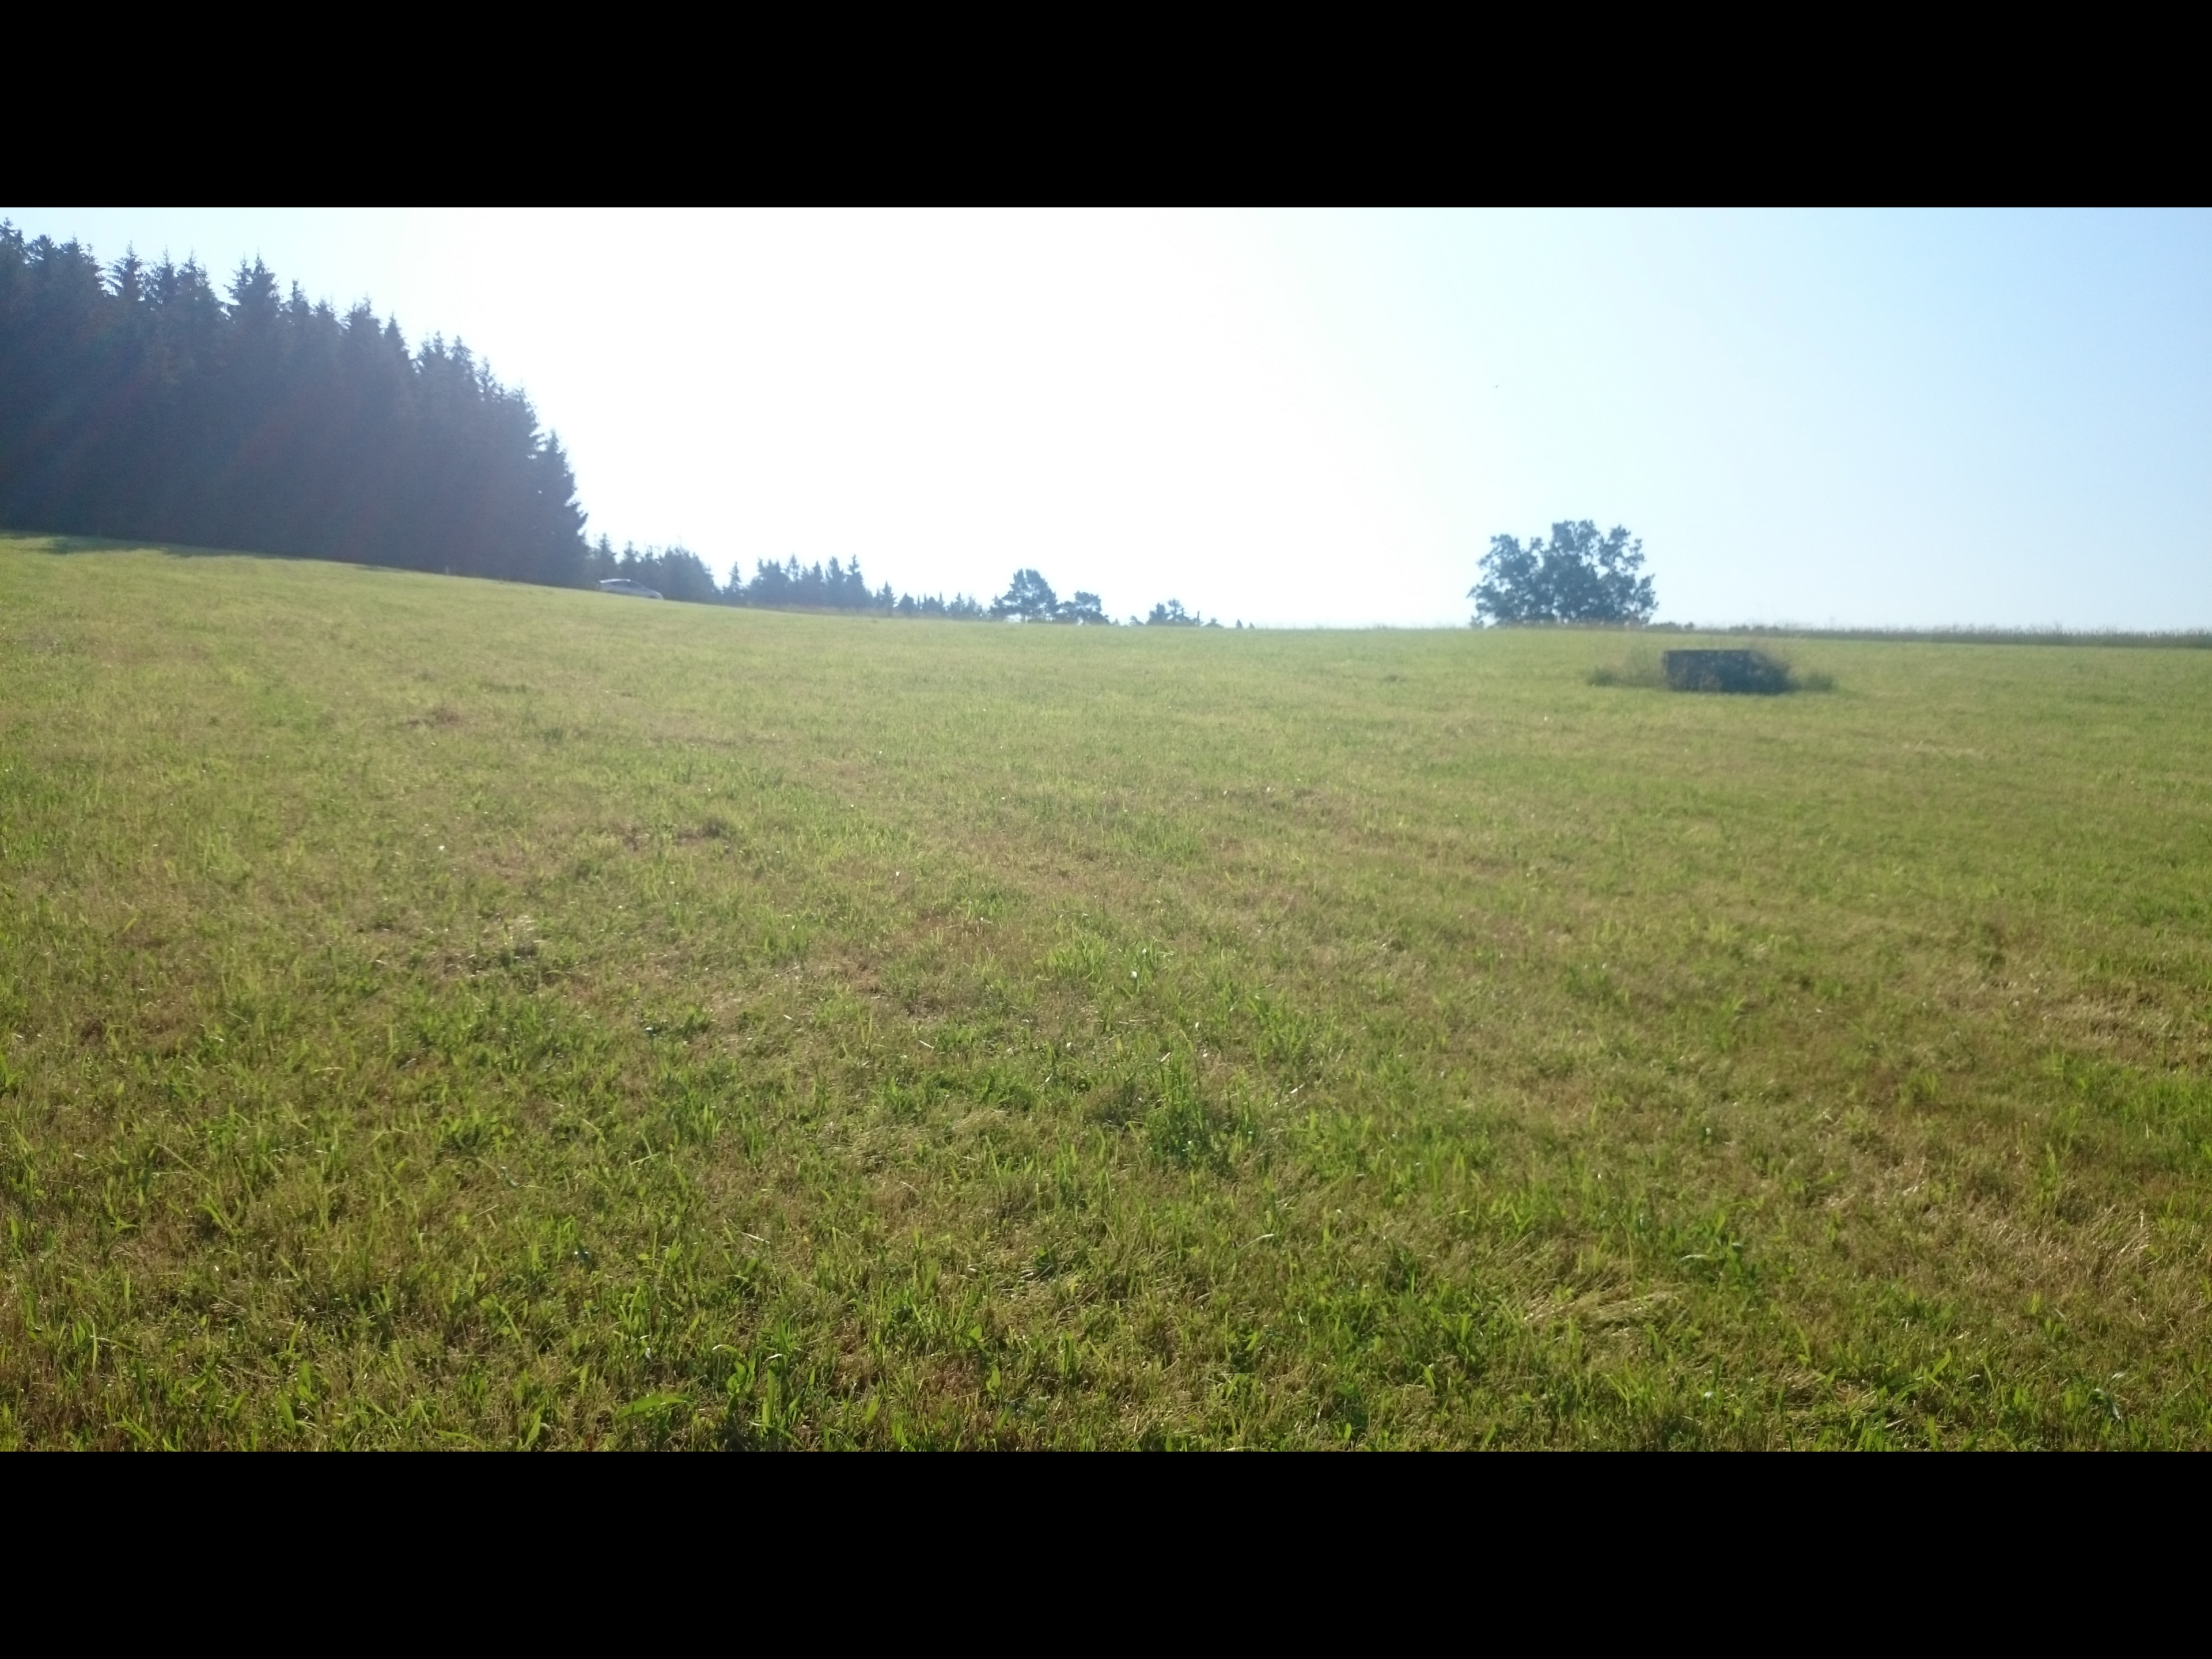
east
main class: Grassland
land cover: Grassland without tree/shrub cover
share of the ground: > 75 %
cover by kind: herbaceous plants 100 %
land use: Agriculture (excluding fallow land and kitchen gardens)
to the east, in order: Grassland without tree/shrub cover; Paved roads, cycling and walking lanes; Grass margins; Spruce dominated coniferous woodland; Shrubland with sparse tree cover
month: June
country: AT
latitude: 48.4526
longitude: 14.5844
